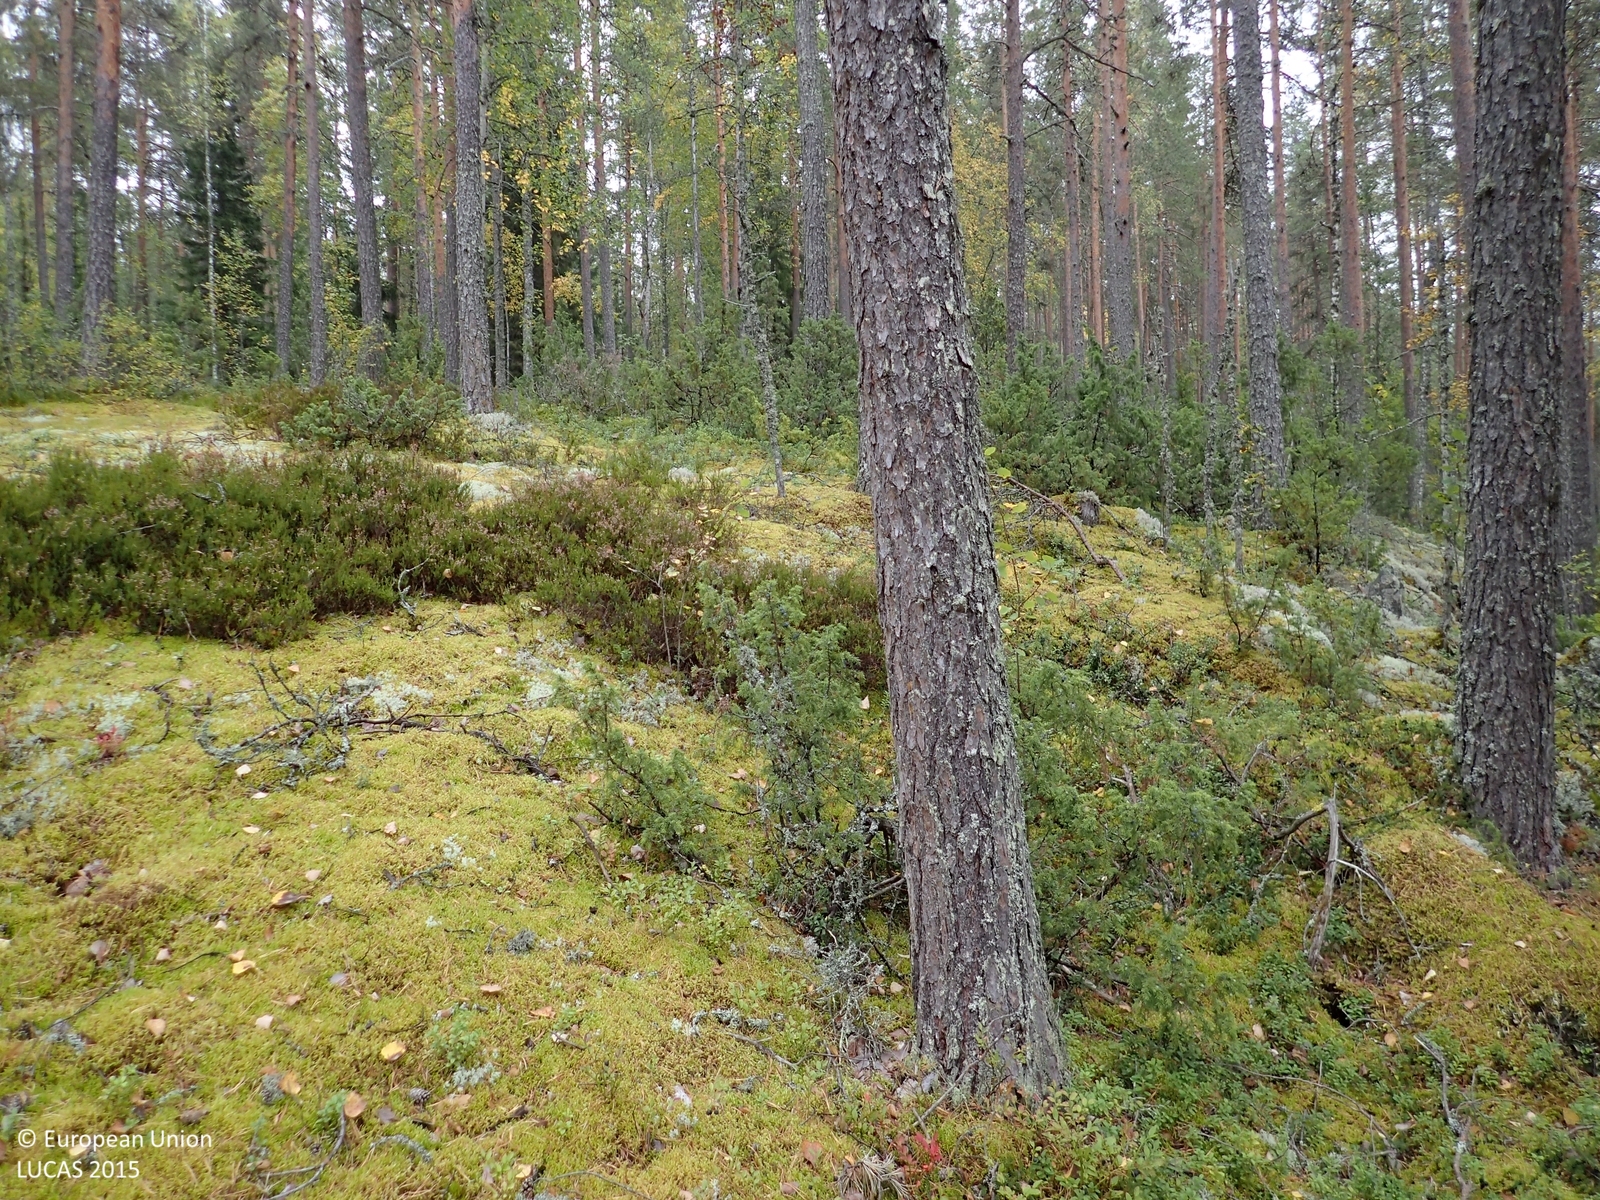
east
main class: Woodland
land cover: Pine dominated mixed woodland
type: boreal forest
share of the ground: > 75 %
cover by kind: coniferous forest trees 55 %, broadleaved forest trees 20 %, lichens and mosses 15 %, shrubs 10 %
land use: Forestry
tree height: > 5 m
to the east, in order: Pine dominated mixed woodland; Other mixed woodland; Tracks; Other mixed woodland; Tracks; Other mixed woodland; Tracks; Other mixed woodland
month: September
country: FI
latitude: 63.0650
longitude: 25.6022
